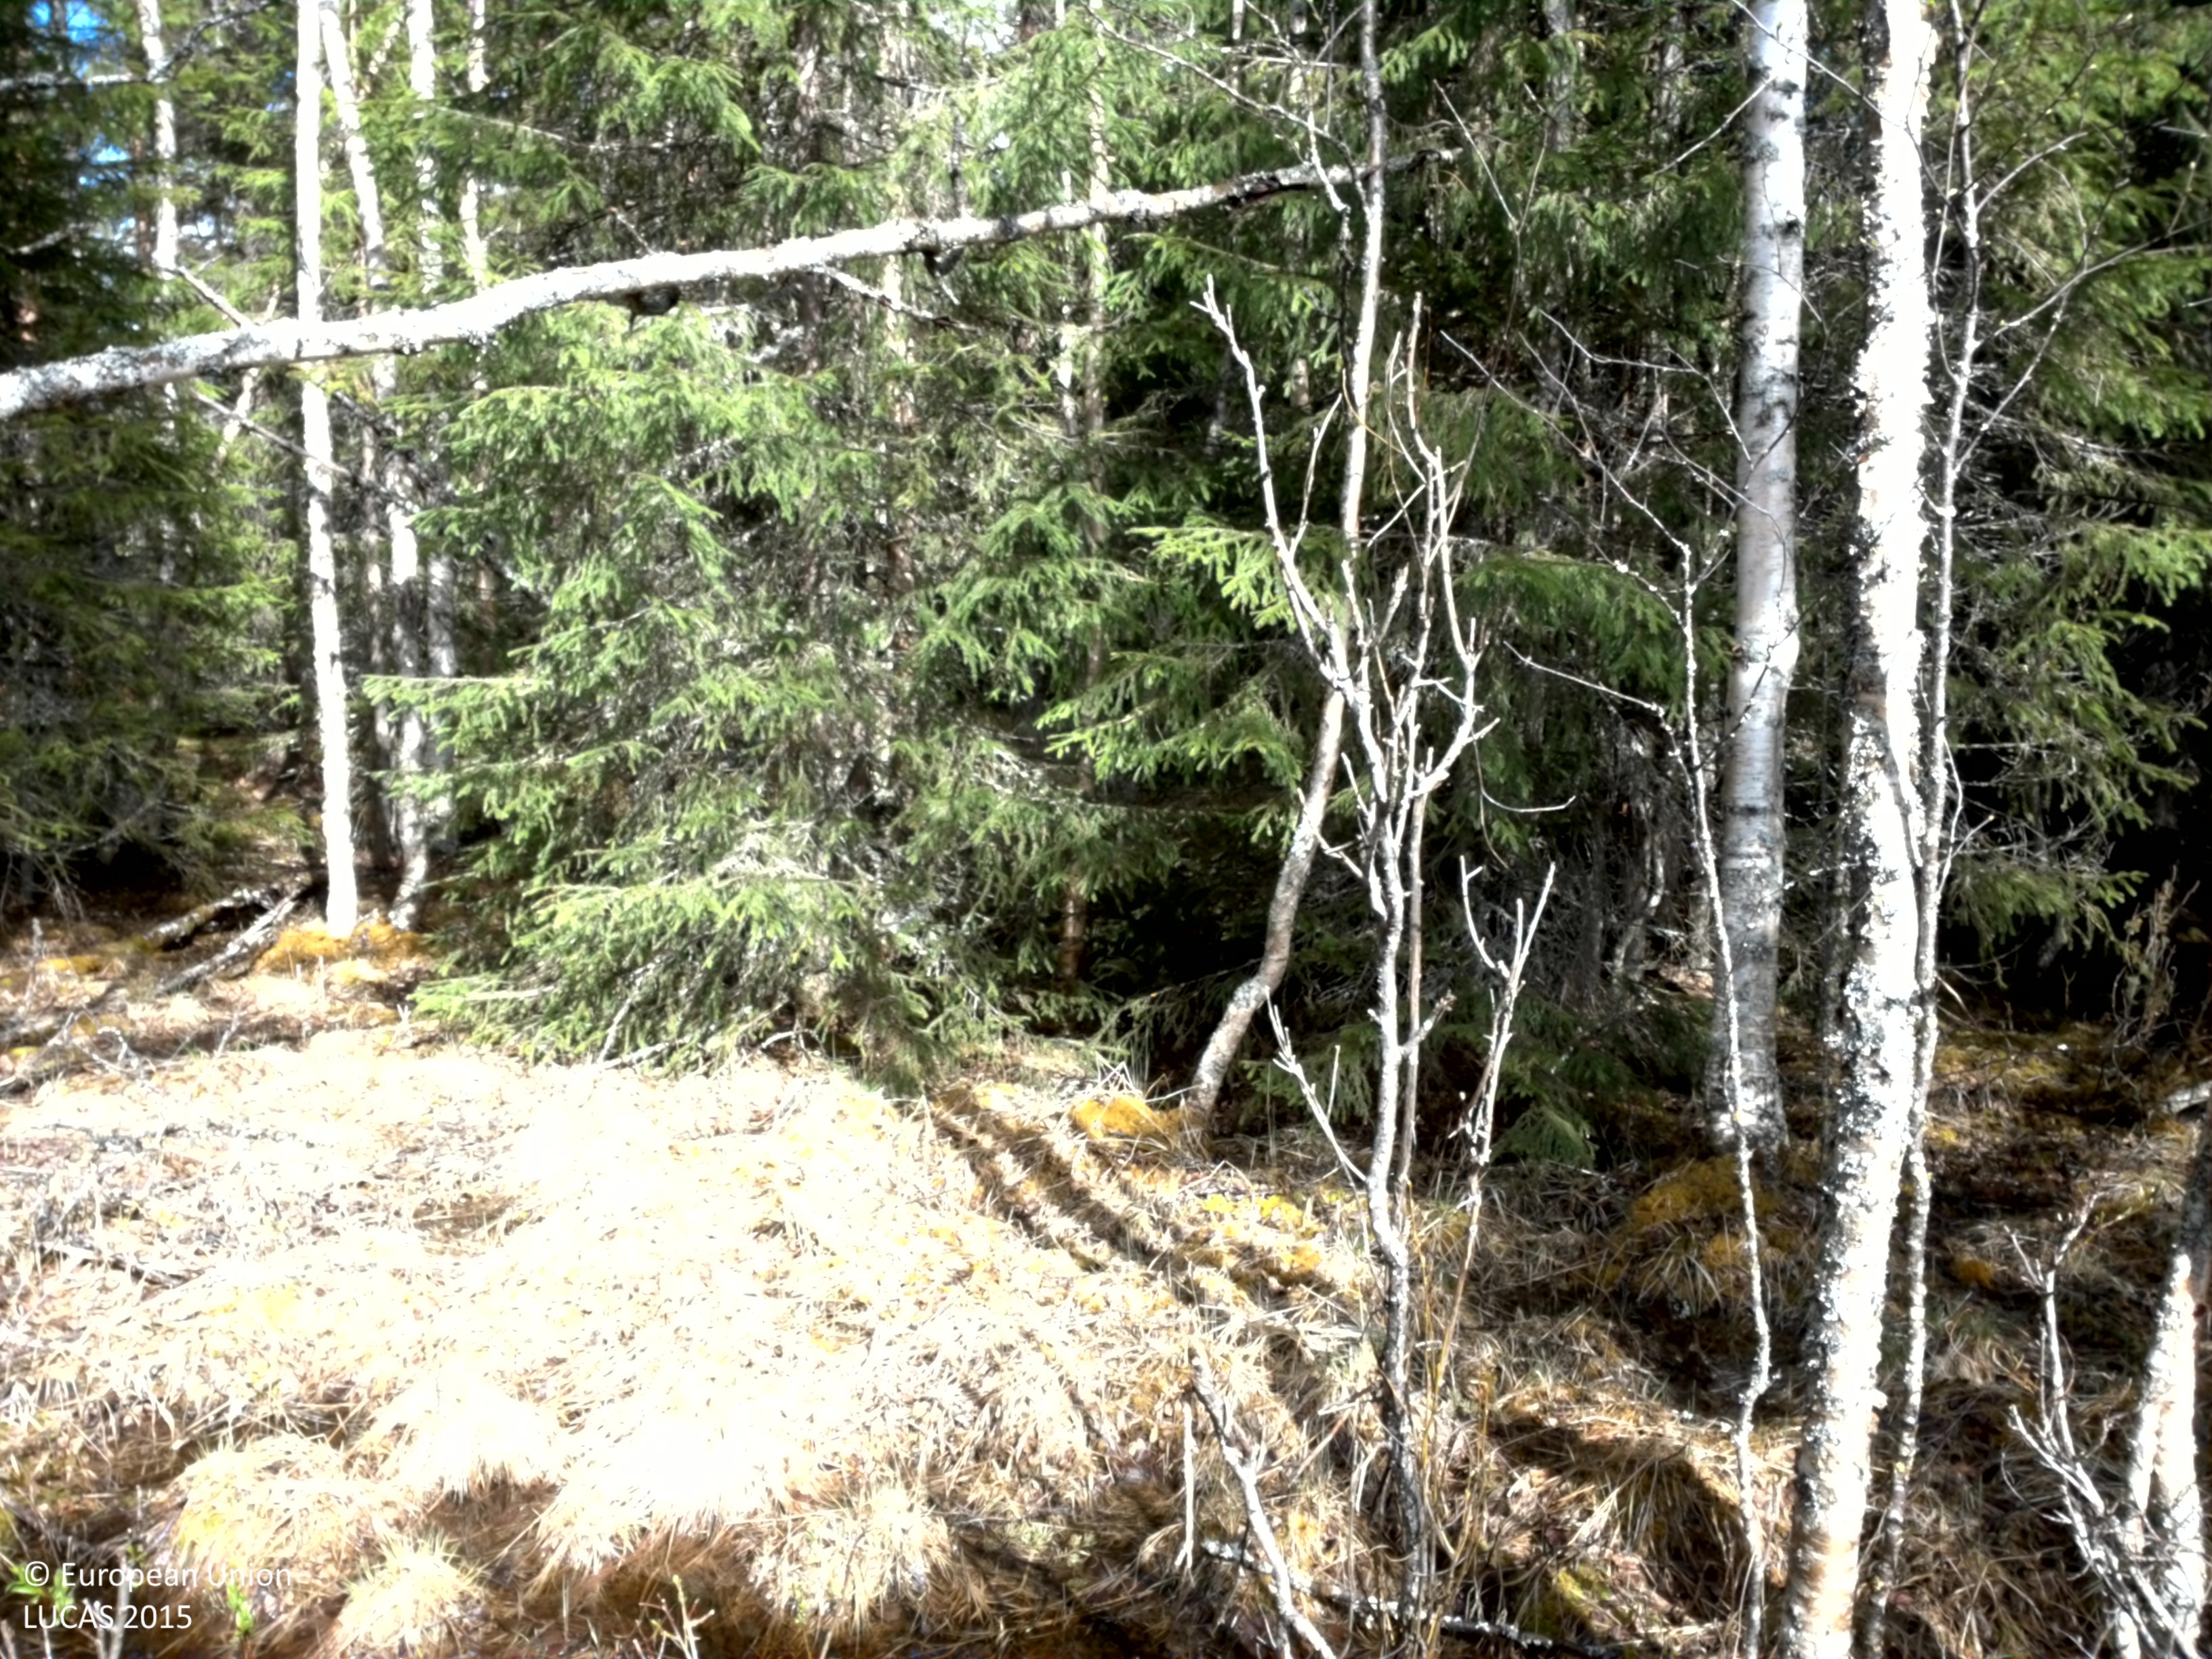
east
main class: Woodland
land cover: Spruce dominated mixed woodland
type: boreal forest
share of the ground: > 75 %
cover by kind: coniferous forest trees 65 %, broadleaved forest trees 25 %, shrubs 10 %
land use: Forestry
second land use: Amenities, museums, leisure
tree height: > 5 m
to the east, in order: Spruce dominated mixed woodland; Pine dominated coniferous woodland; Spruce dominated coniferous woodland; Rivers and streams; Spruce dominated mixed woodland; Broadleaved woodland; Spruce dominated mixed woodland
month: June
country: SE
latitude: 63.6071
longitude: 14.6347
